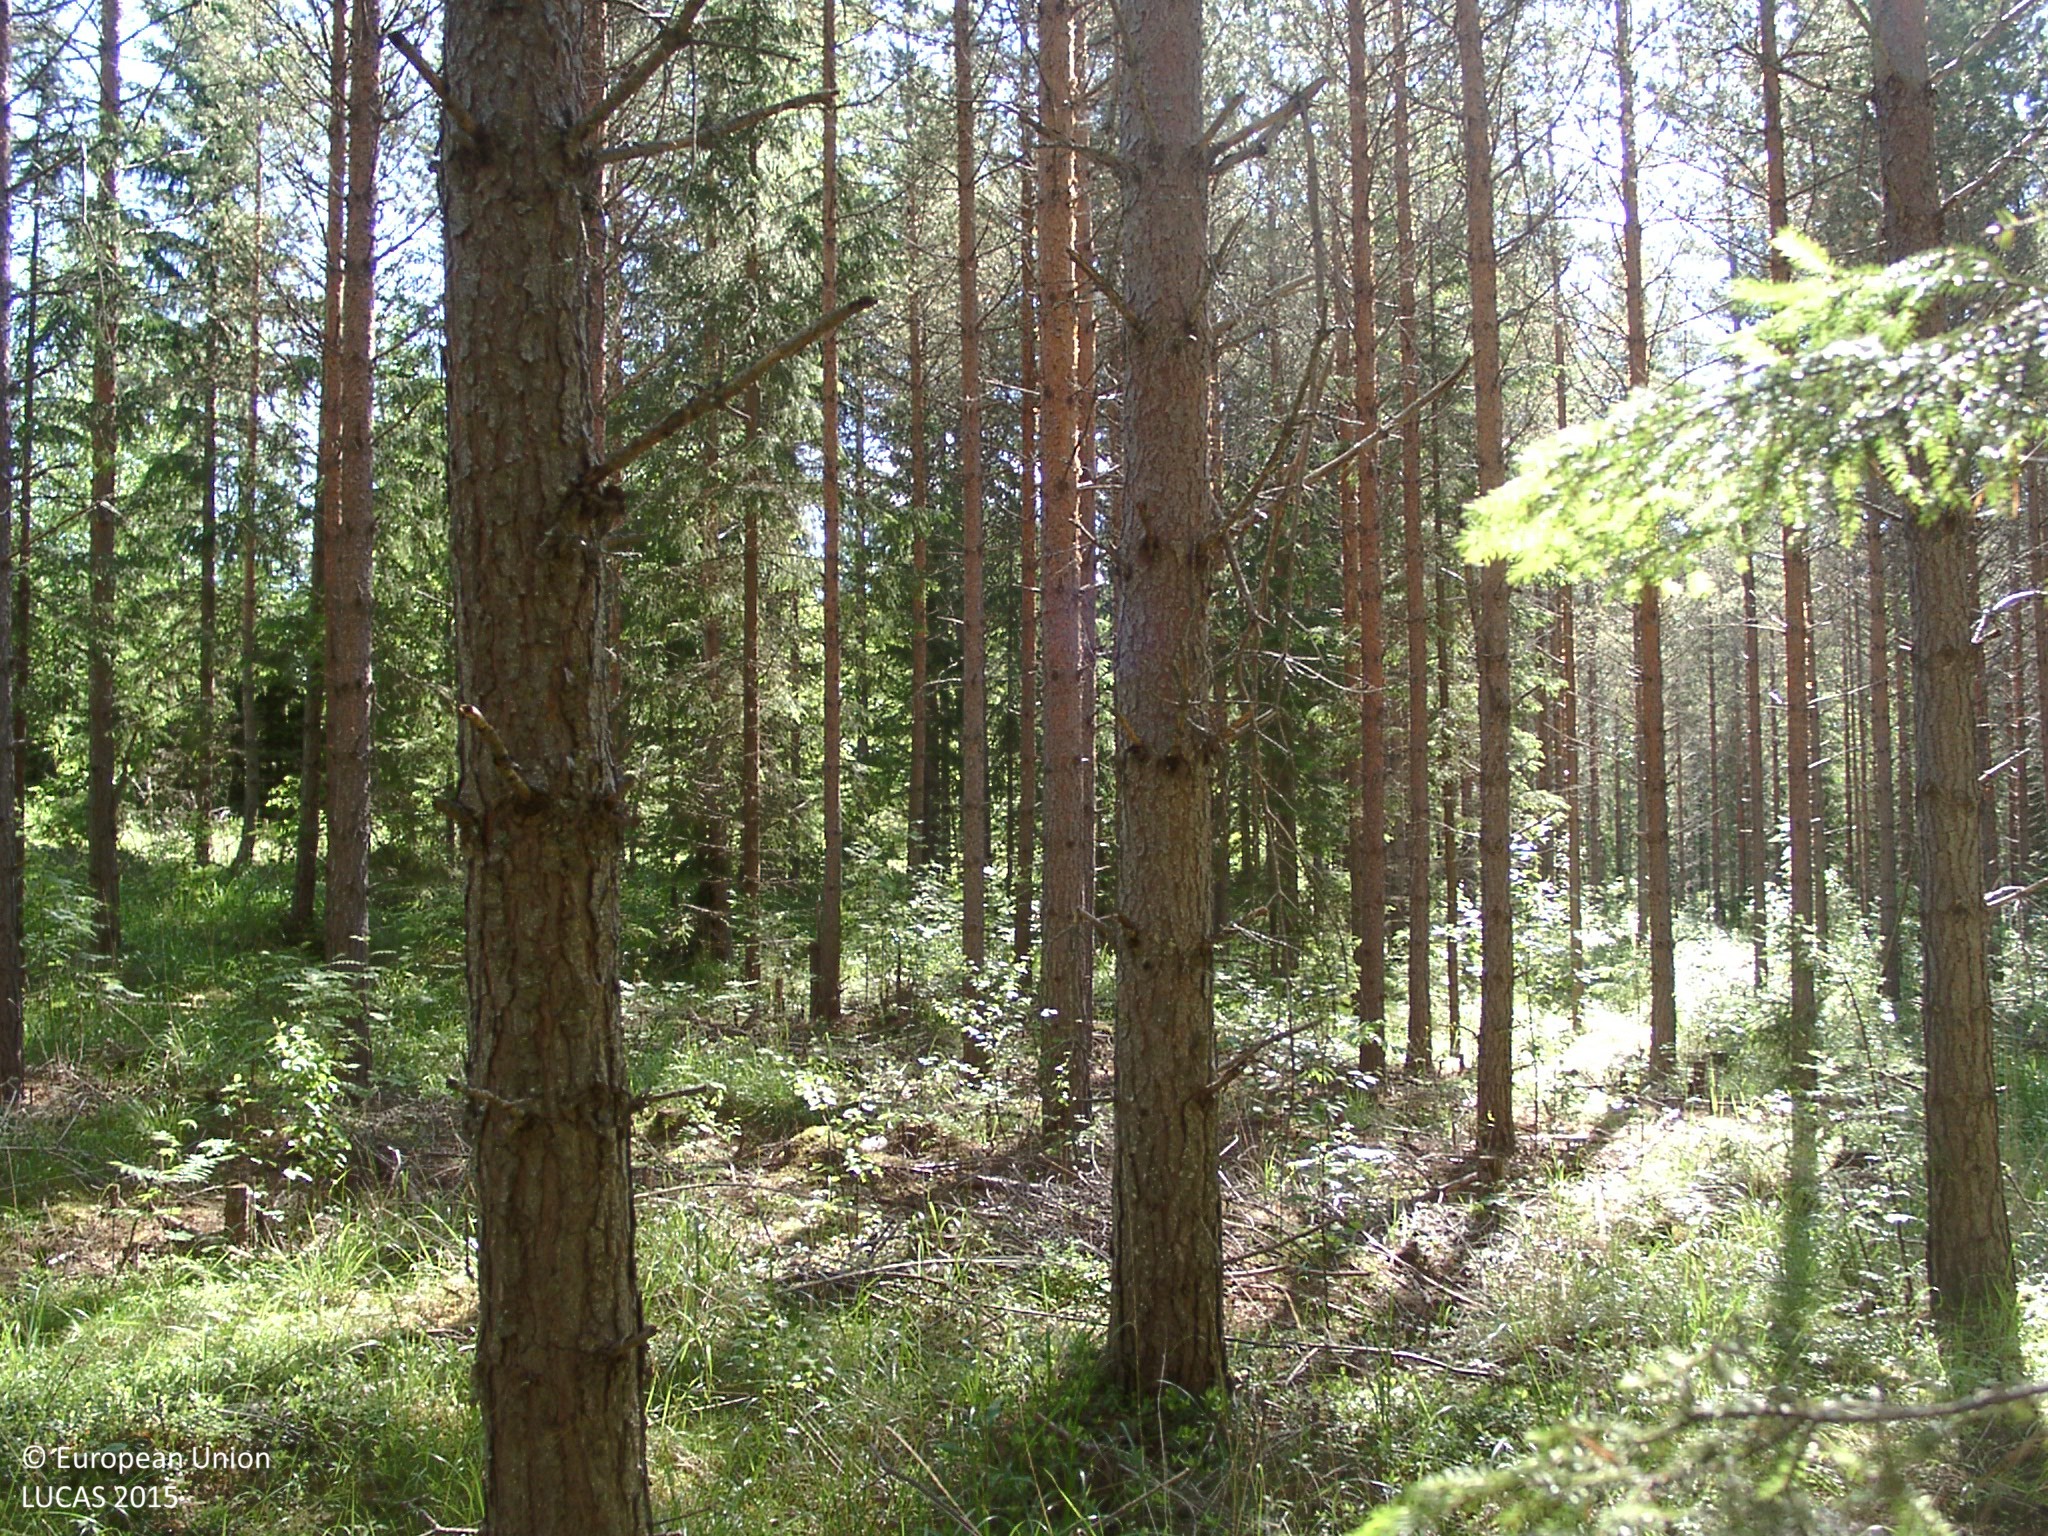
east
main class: Woodland
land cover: Other coniferous woodland
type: boreal forest
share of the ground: 50 - 75 %
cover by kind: coniferous forest trees 60 %, herbaceous plants 20 %, broadleaved forest trees 5 %, shrubs 5 %, lichens and mosses 5 %
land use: Forestry
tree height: > 5 m
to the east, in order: Other coniferous woodland; Grass margins; Spruce dominated mixed woodland; Grassland with sparse tree/shrub cover; Shrubland without tree cover; Broadleaved woodland; Other mixed woodland; Broadleaved woodland; Tracks; Other mixed woodland; Grassland with sparse tree/shrub cover; Electric lines; Grassland with sparse tree/shrub cover; Paved roads, cycling and walking lanes; Grassland with sparse tree/shrub cover; Ditches and canals; Grassland with sparse tree/shrub cover; Electric lines; Grassland with sparse tree/shrub cover; Spruce dominated mixed woodland
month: June
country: FI
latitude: 62.1267
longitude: 25.0408
